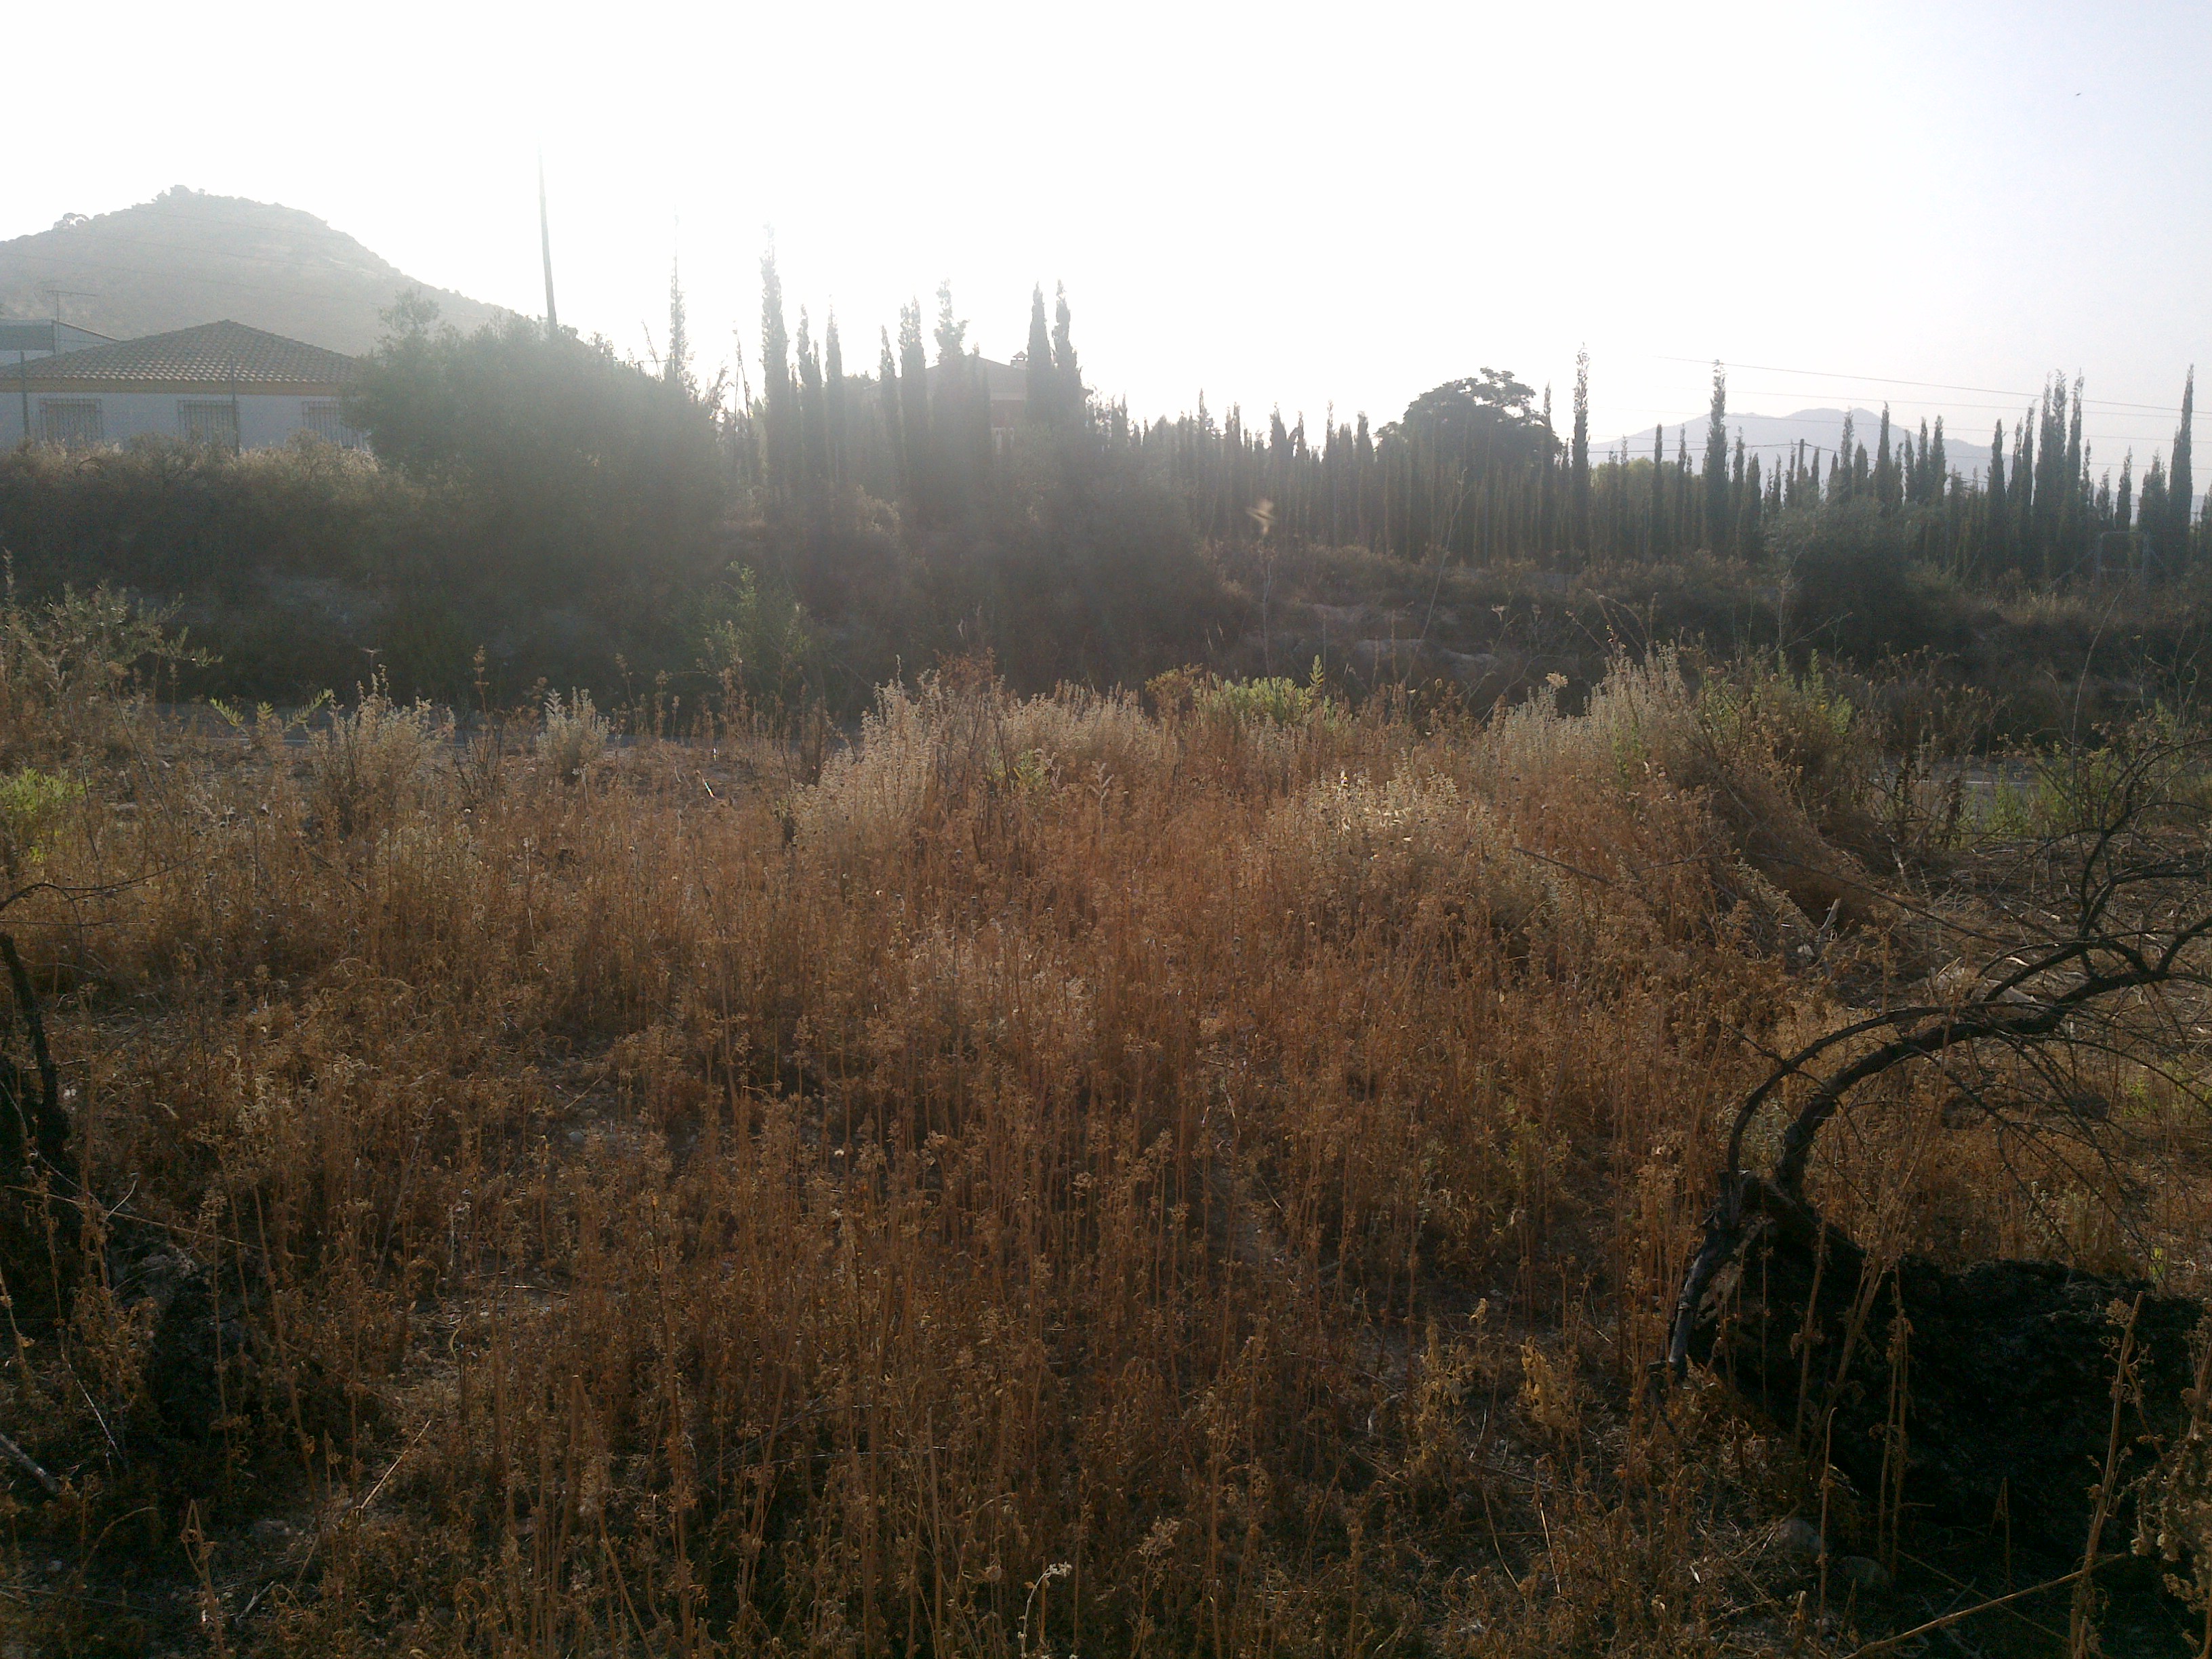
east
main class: Cropland
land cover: Olive groves
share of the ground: 25 - 50 %
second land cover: Spontaneously vegetated surfaces
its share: 25 - 50 %
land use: Agriculture (excluding fallow land and kitchen gardens)
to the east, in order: Olive groves; Spontaneously vegetated surfaces; Grass margins; Ditches and canals; Paved roads, cycling and walking lanes; Ditches and canals; Grass margins; Electric lines; Fences; Conifer hedges; Managed hedges; Artificial constructions in urban areas; Olive groves
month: July
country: ES
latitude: 37.3671
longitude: -4.4890
